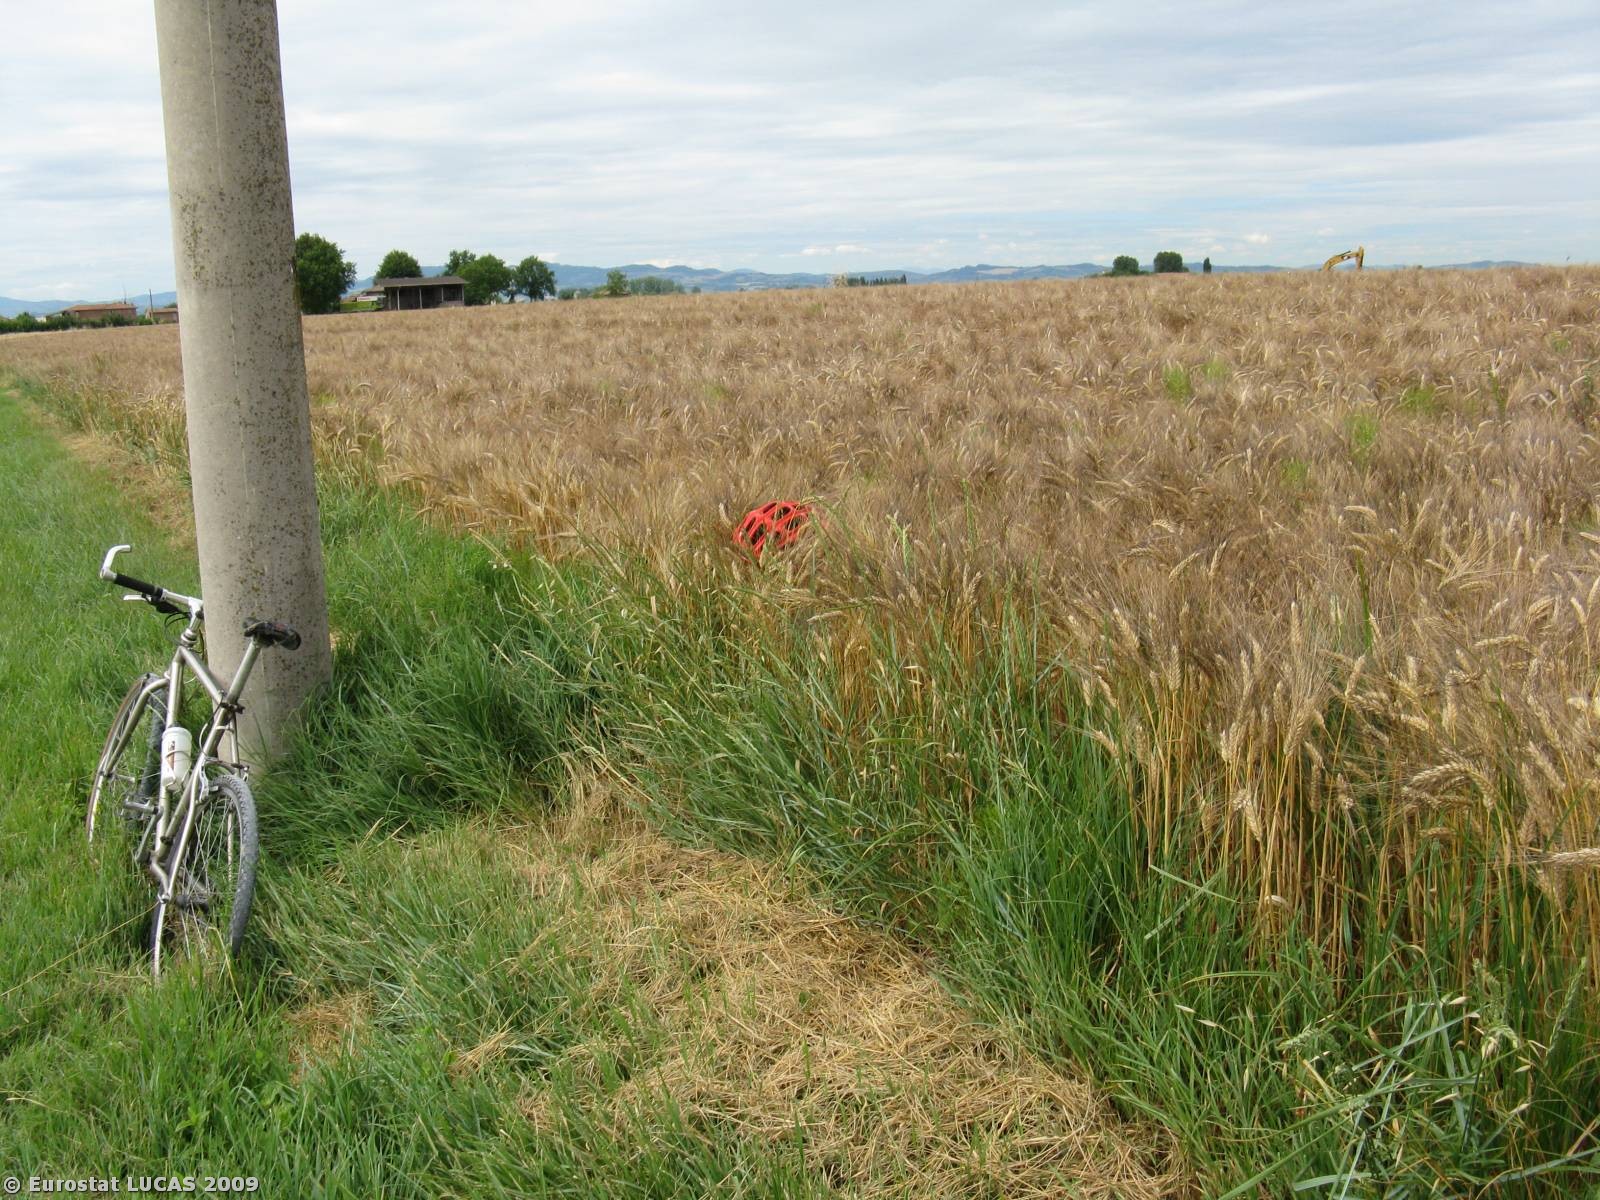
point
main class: Cropland
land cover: Durum wheat
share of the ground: > 75 %
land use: Agriculture (excluding fallow land and kitchen gardens)
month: June
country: IT
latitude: 44.4638
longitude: 11.6430
